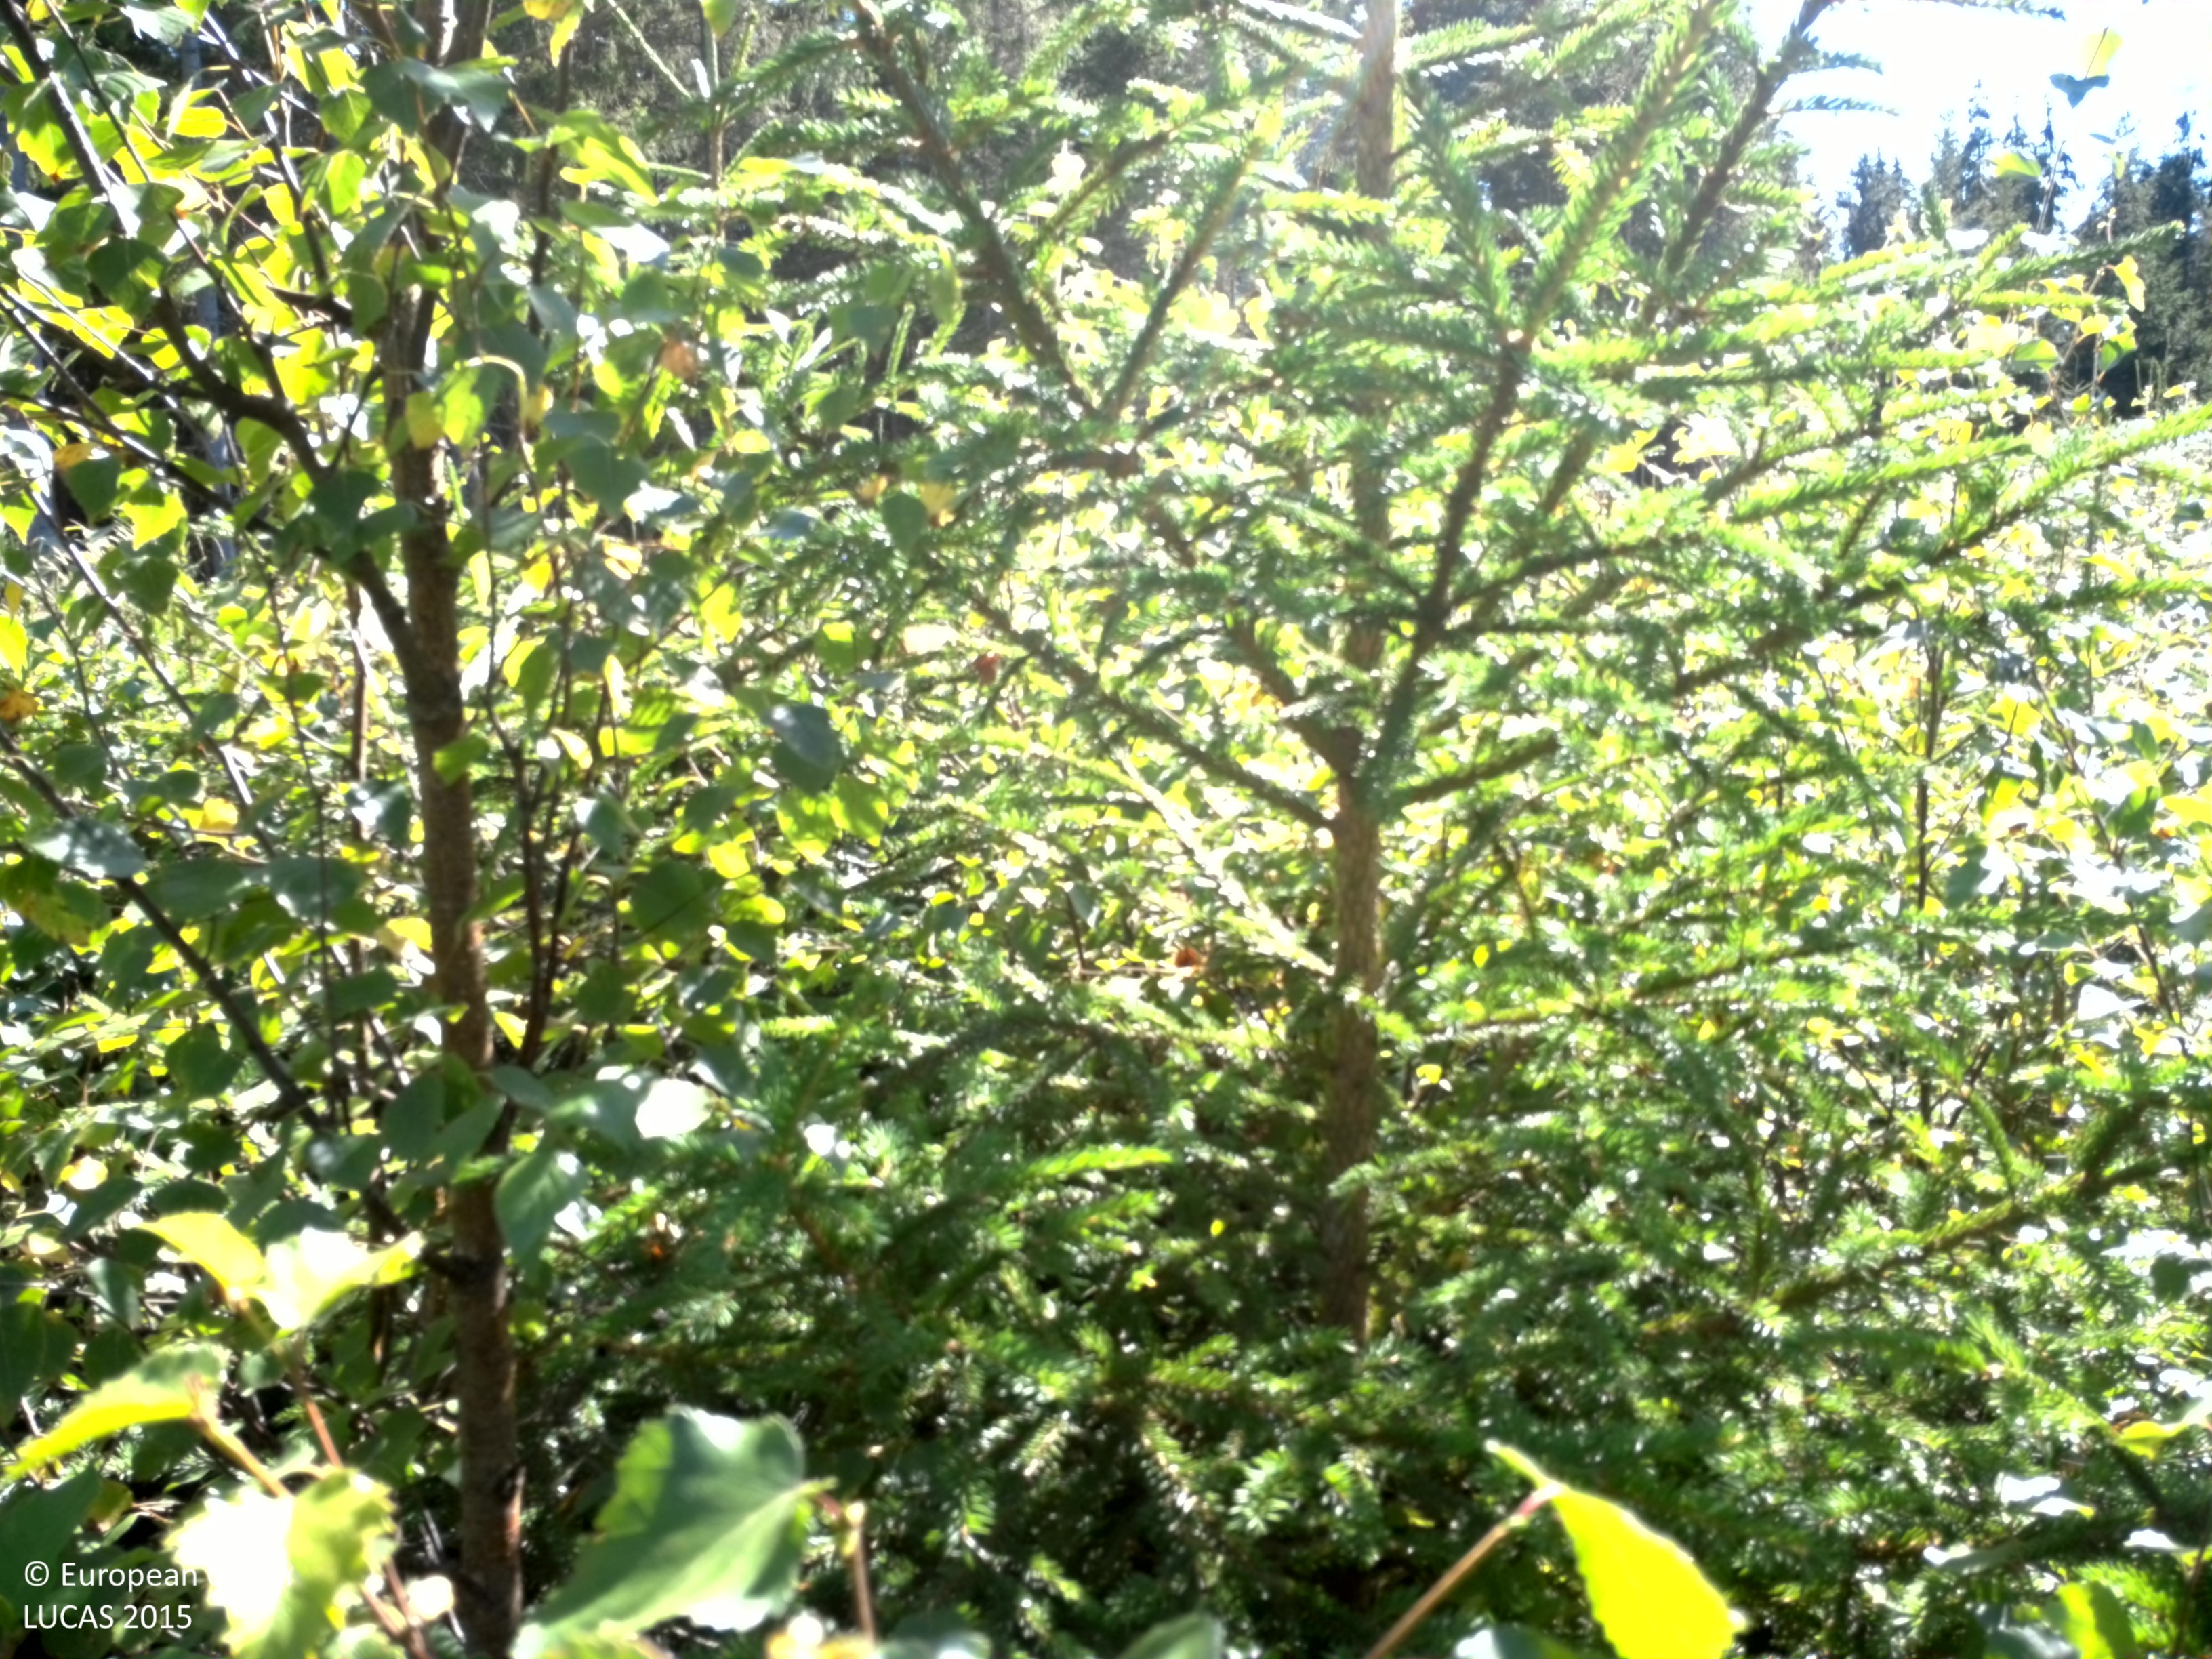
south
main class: Woodland
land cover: Spruce dominated mixed woodland
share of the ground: > 75 %
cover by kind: coniferous forest trees 50 %, broadleaved forest trees 45 %, herbaceous plants 5 %
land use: Forestry
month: August
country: SE
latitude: 58.2498
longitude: 13.3509
